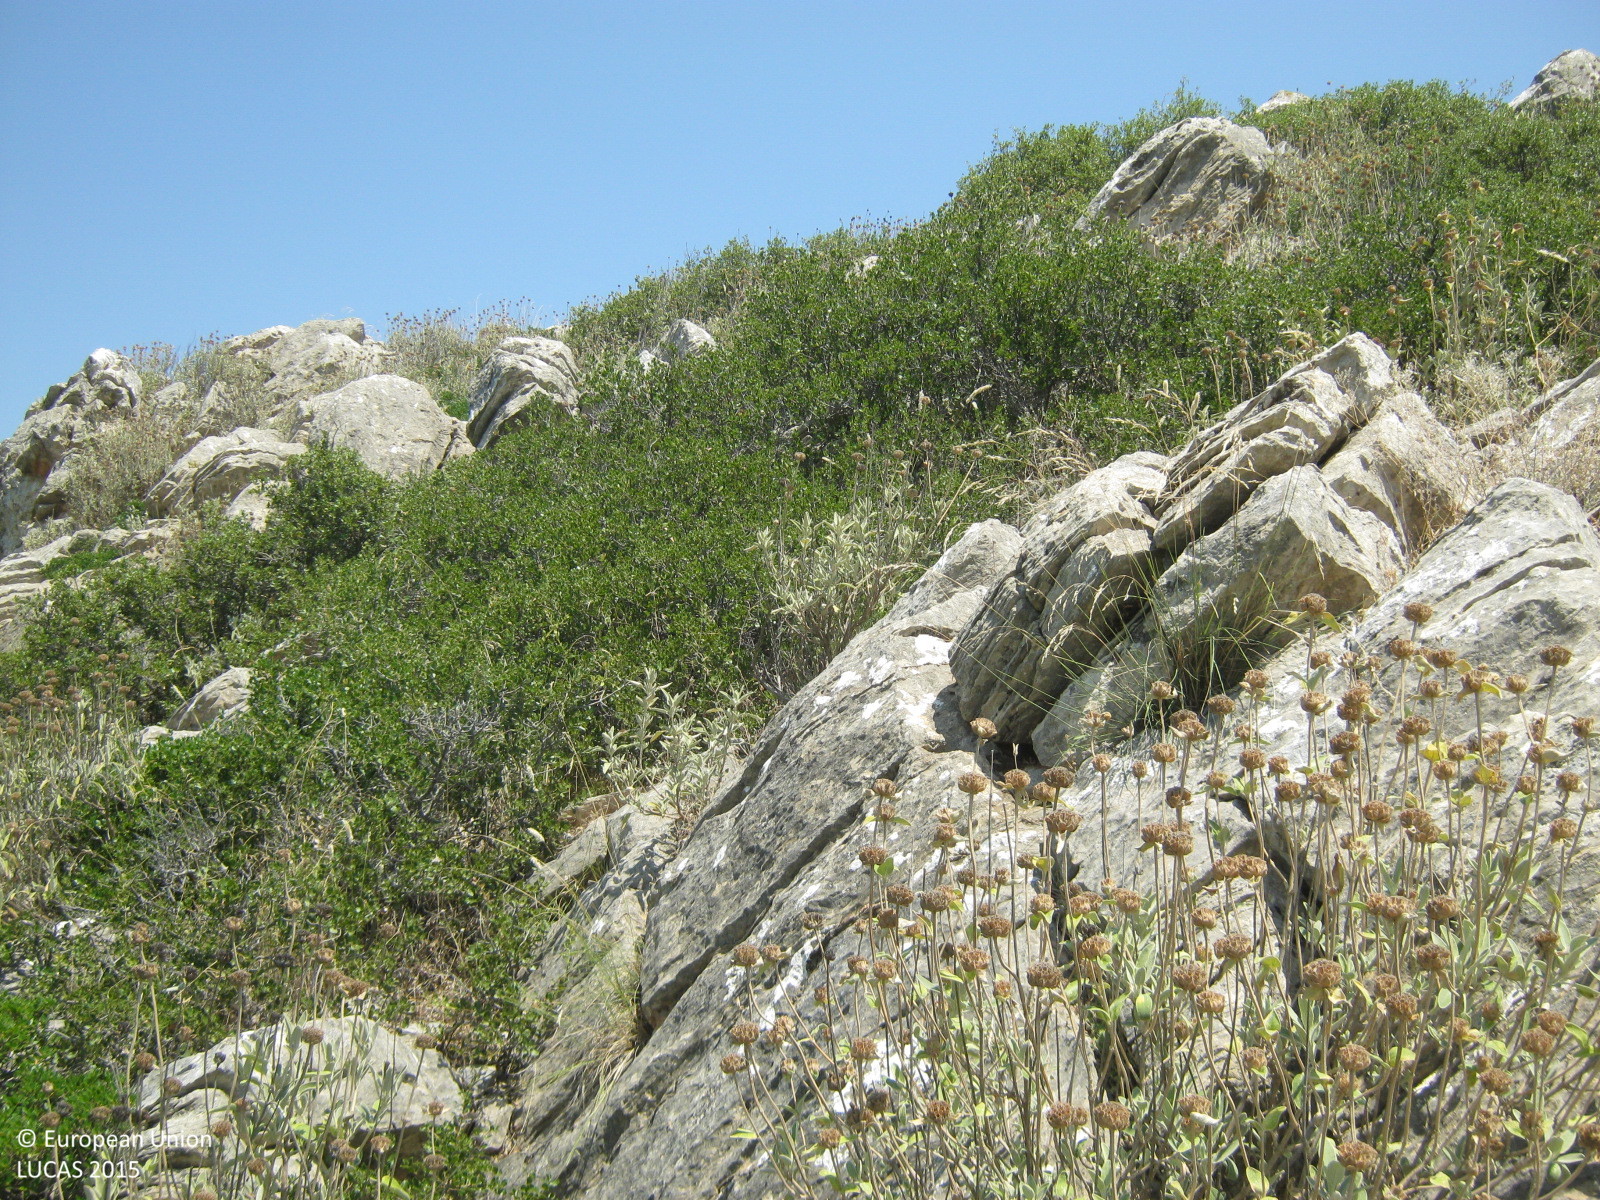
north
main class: Shrubland
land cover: Shrubland without tree cover
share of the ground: 50 - 75 %
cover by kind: shrubs 70 %, unconsolidated bare surface 20 %, herbaceous plants 10 %
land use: Abandoned areas
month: July
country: GR
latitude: 39.2971
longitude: 22.6615
